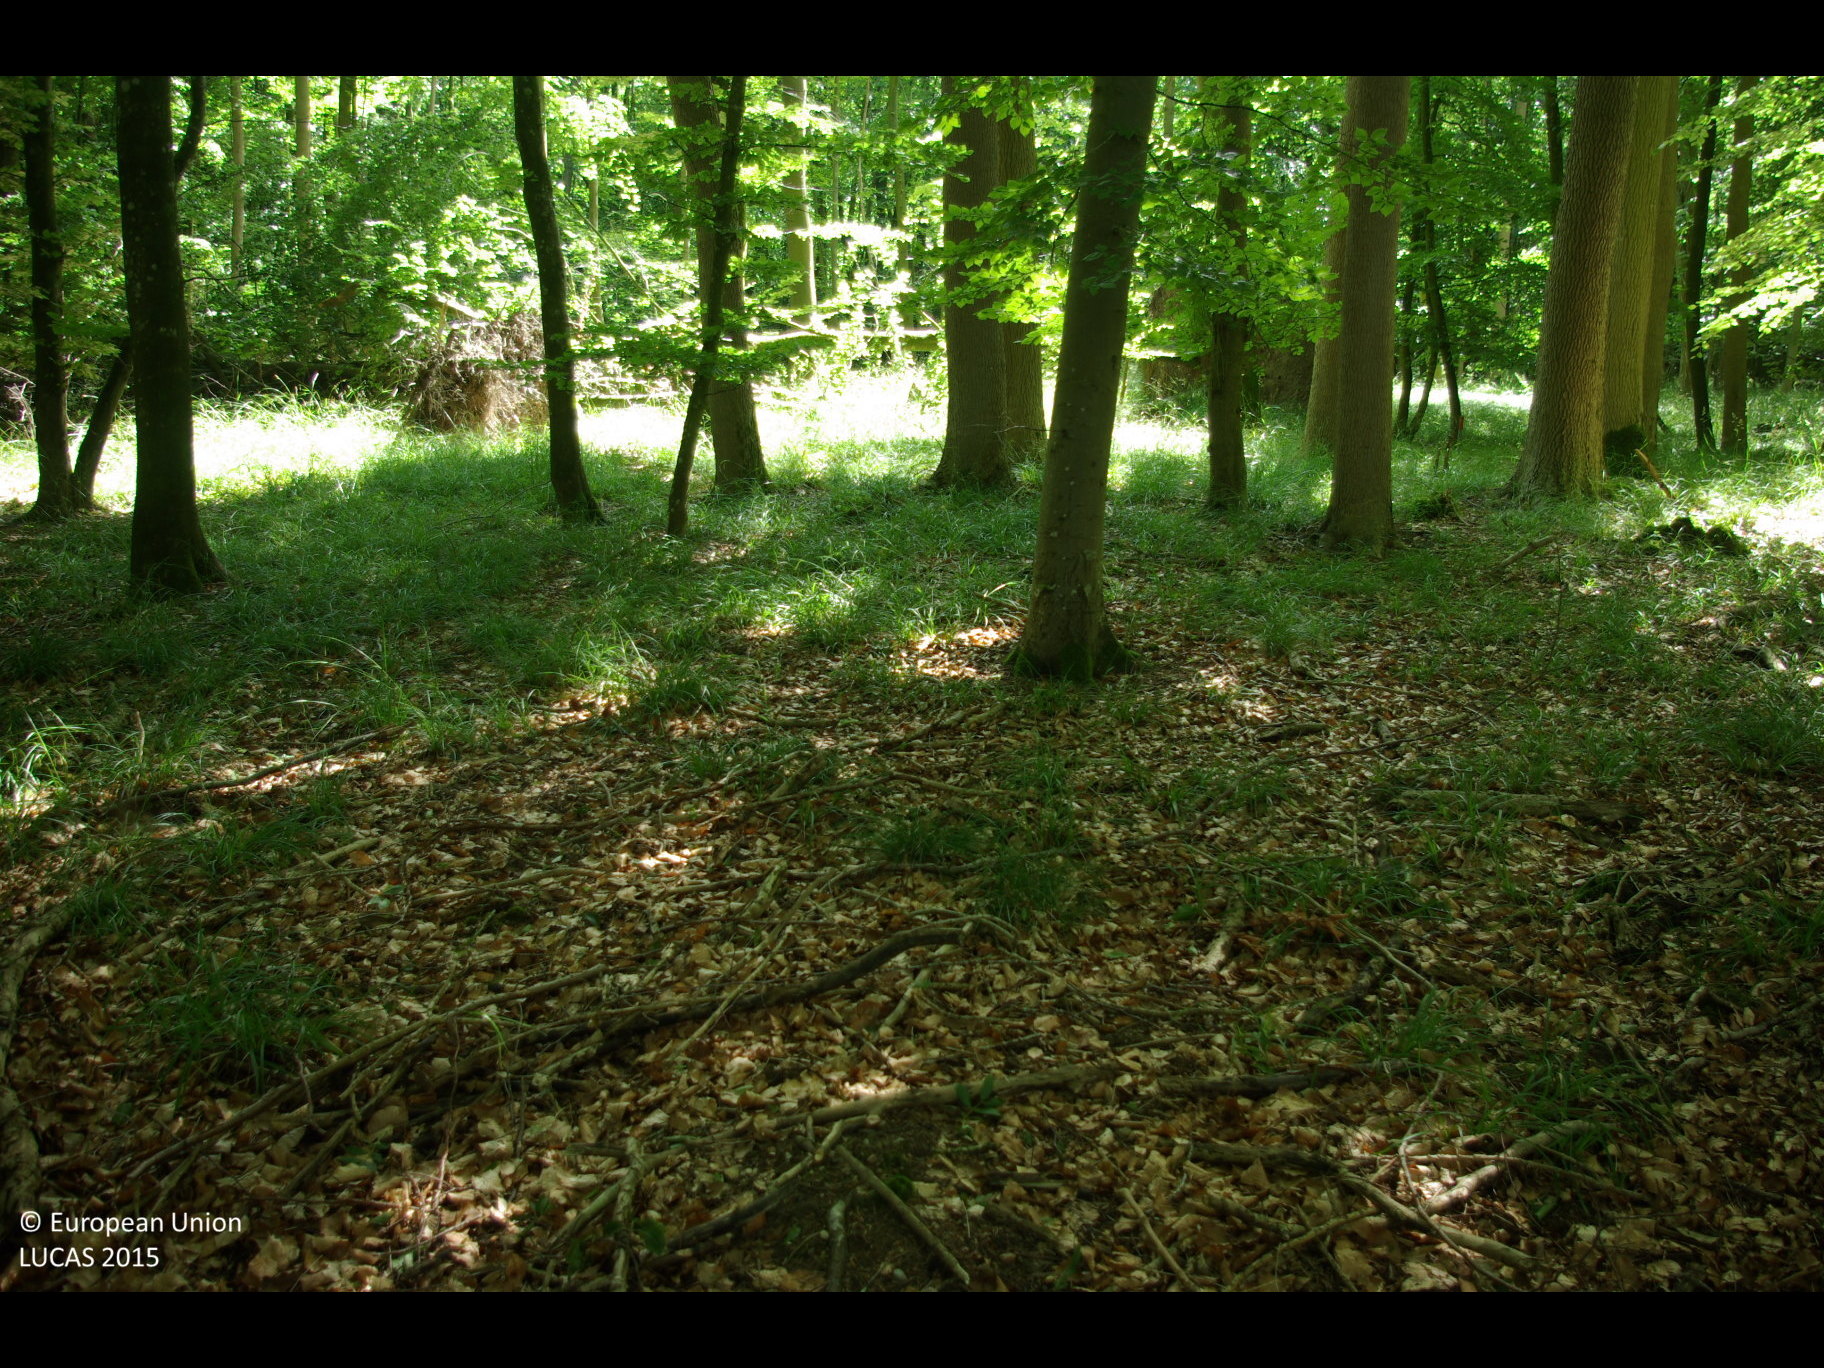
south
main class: Woodland
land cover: Broadleaved woodland
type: mesophytic deciduous forest
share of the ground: > 75 %
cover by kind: broadleaved forest trees 95 %, unconsolidated bare surface 5 %
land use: Forestry
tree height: > 5 m
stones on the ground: 10 - 25 %
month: July
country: DE
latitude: 54.3884
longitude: 9.3075
